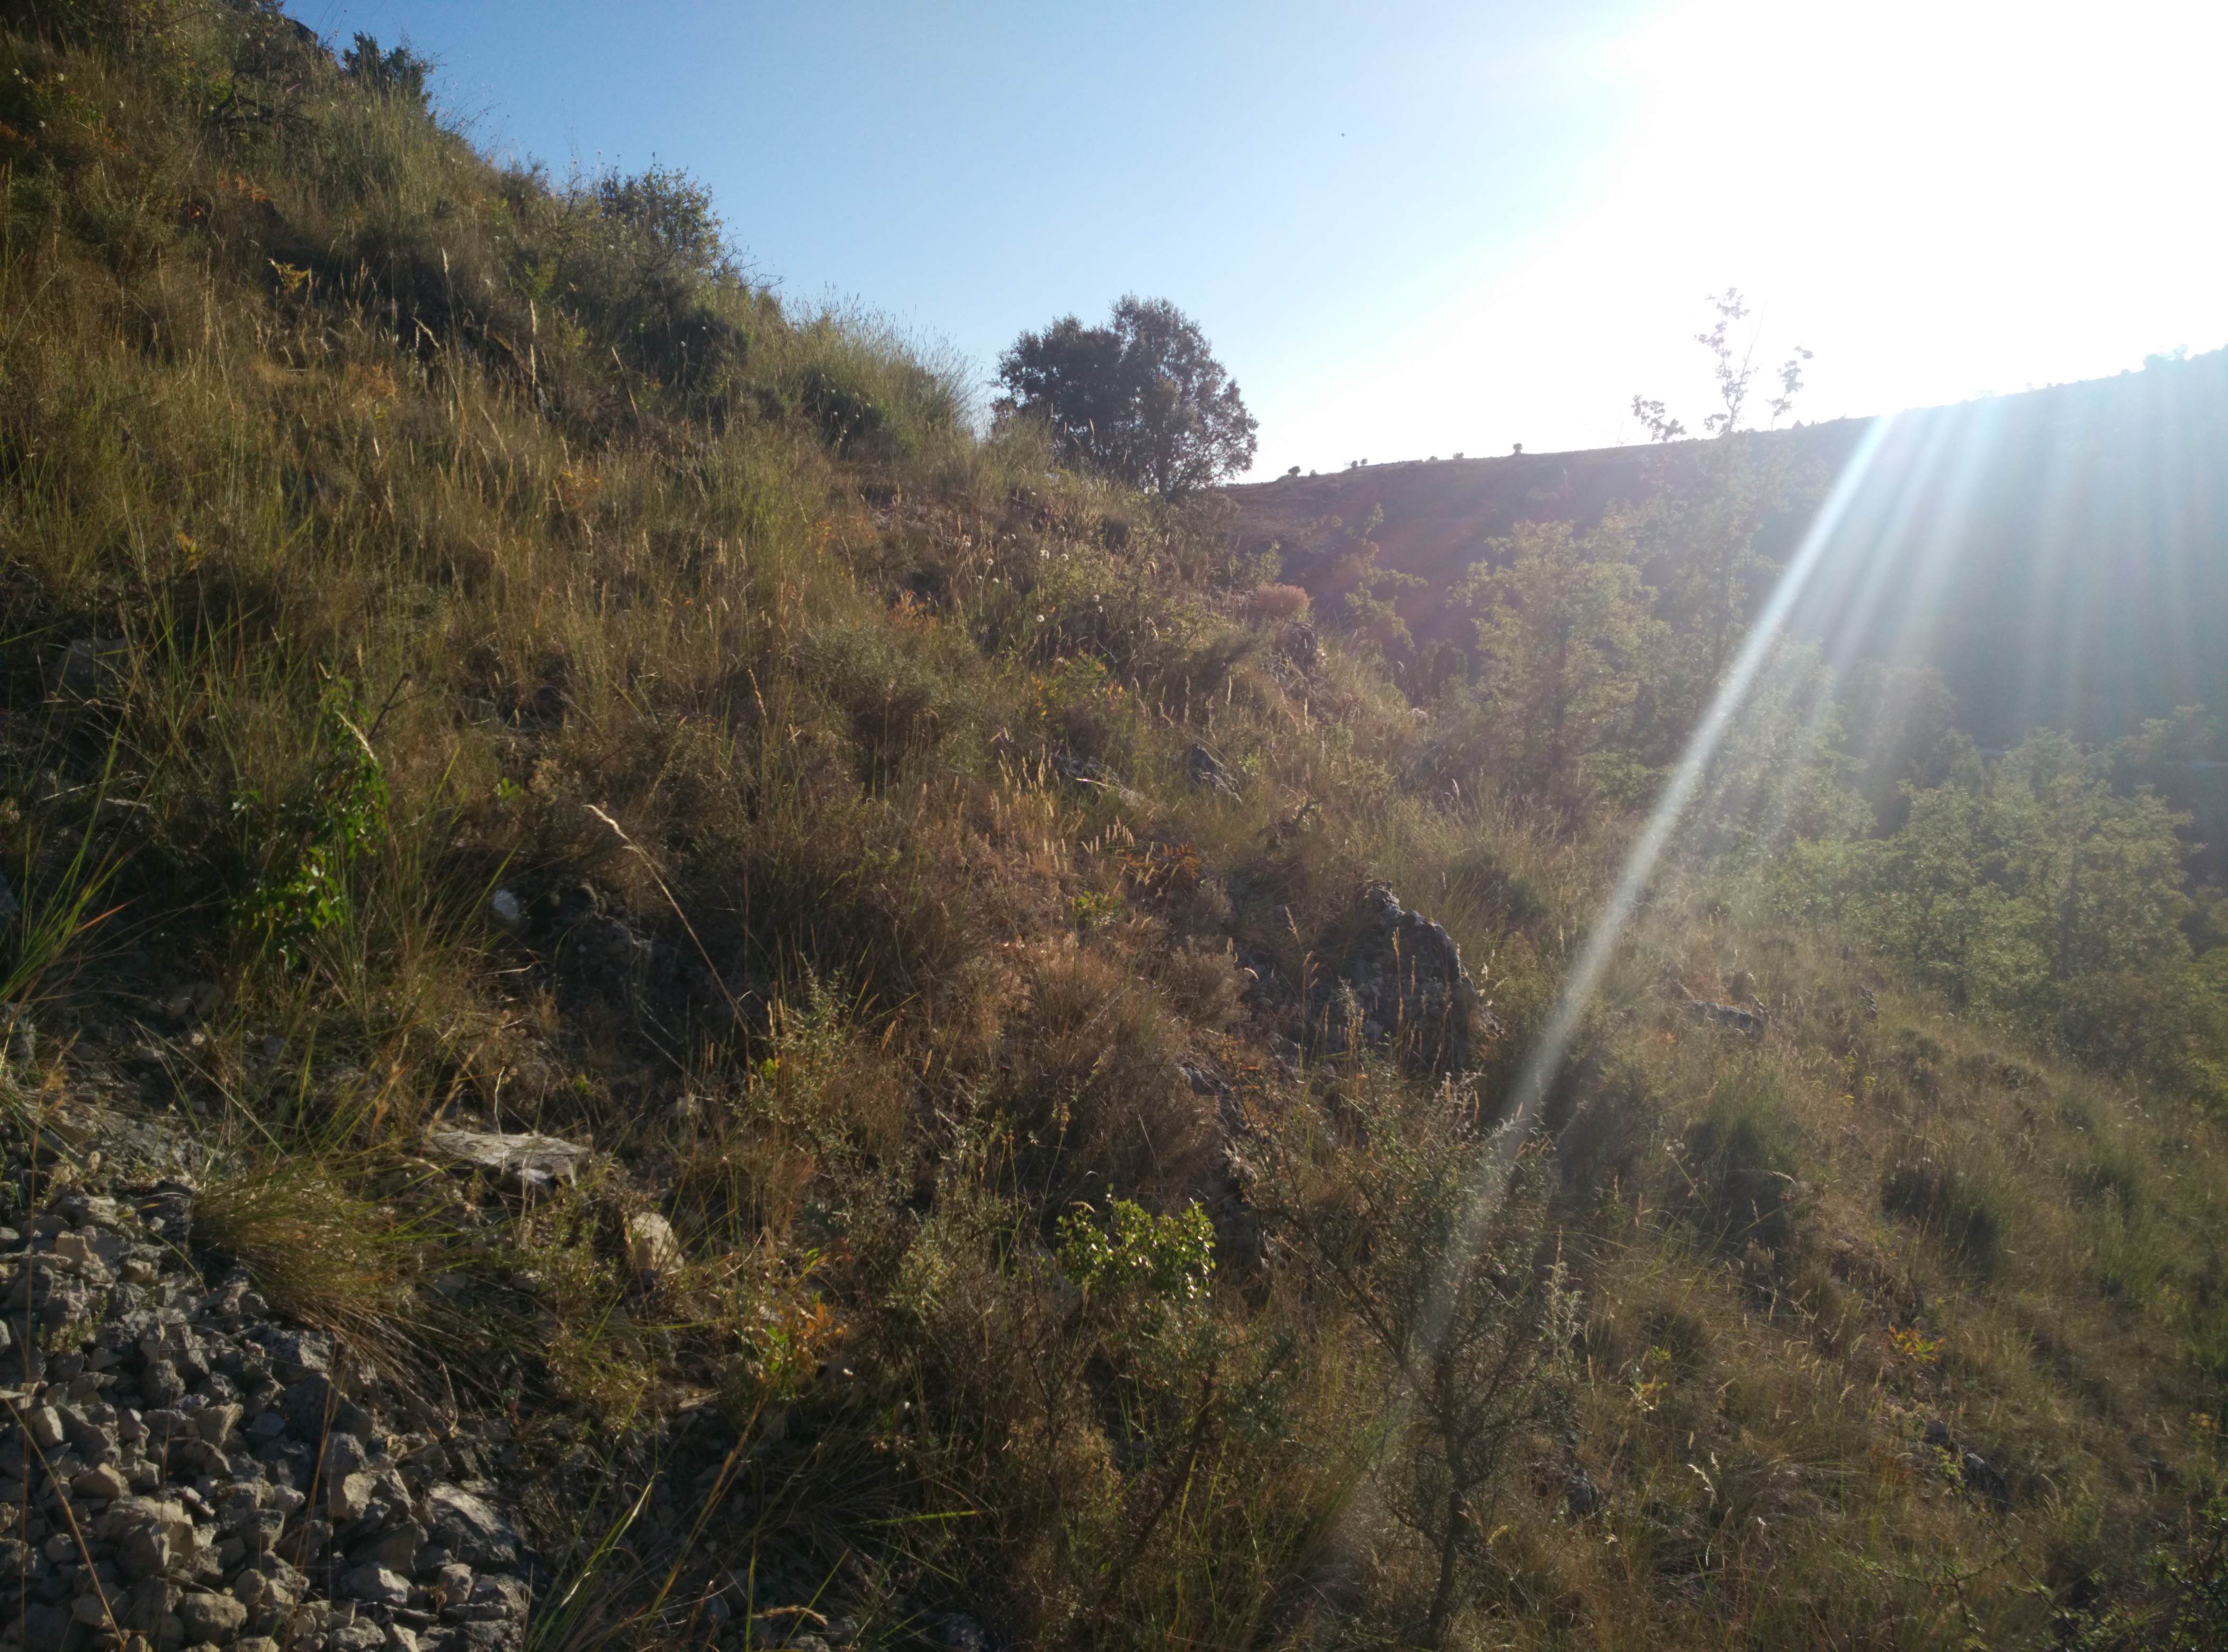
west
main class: Shrubland
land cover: Shrubland with sparse tree cover
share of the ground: 50 - 75 %
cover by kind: shrubs 50 %, unconsolidated bare surface 45 %, broadleaved forest trees 5 %
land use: Semi-natural and natural areas not in use
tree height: > 5 m
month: July
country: ES
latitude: 40.5776
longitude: -2.7987
